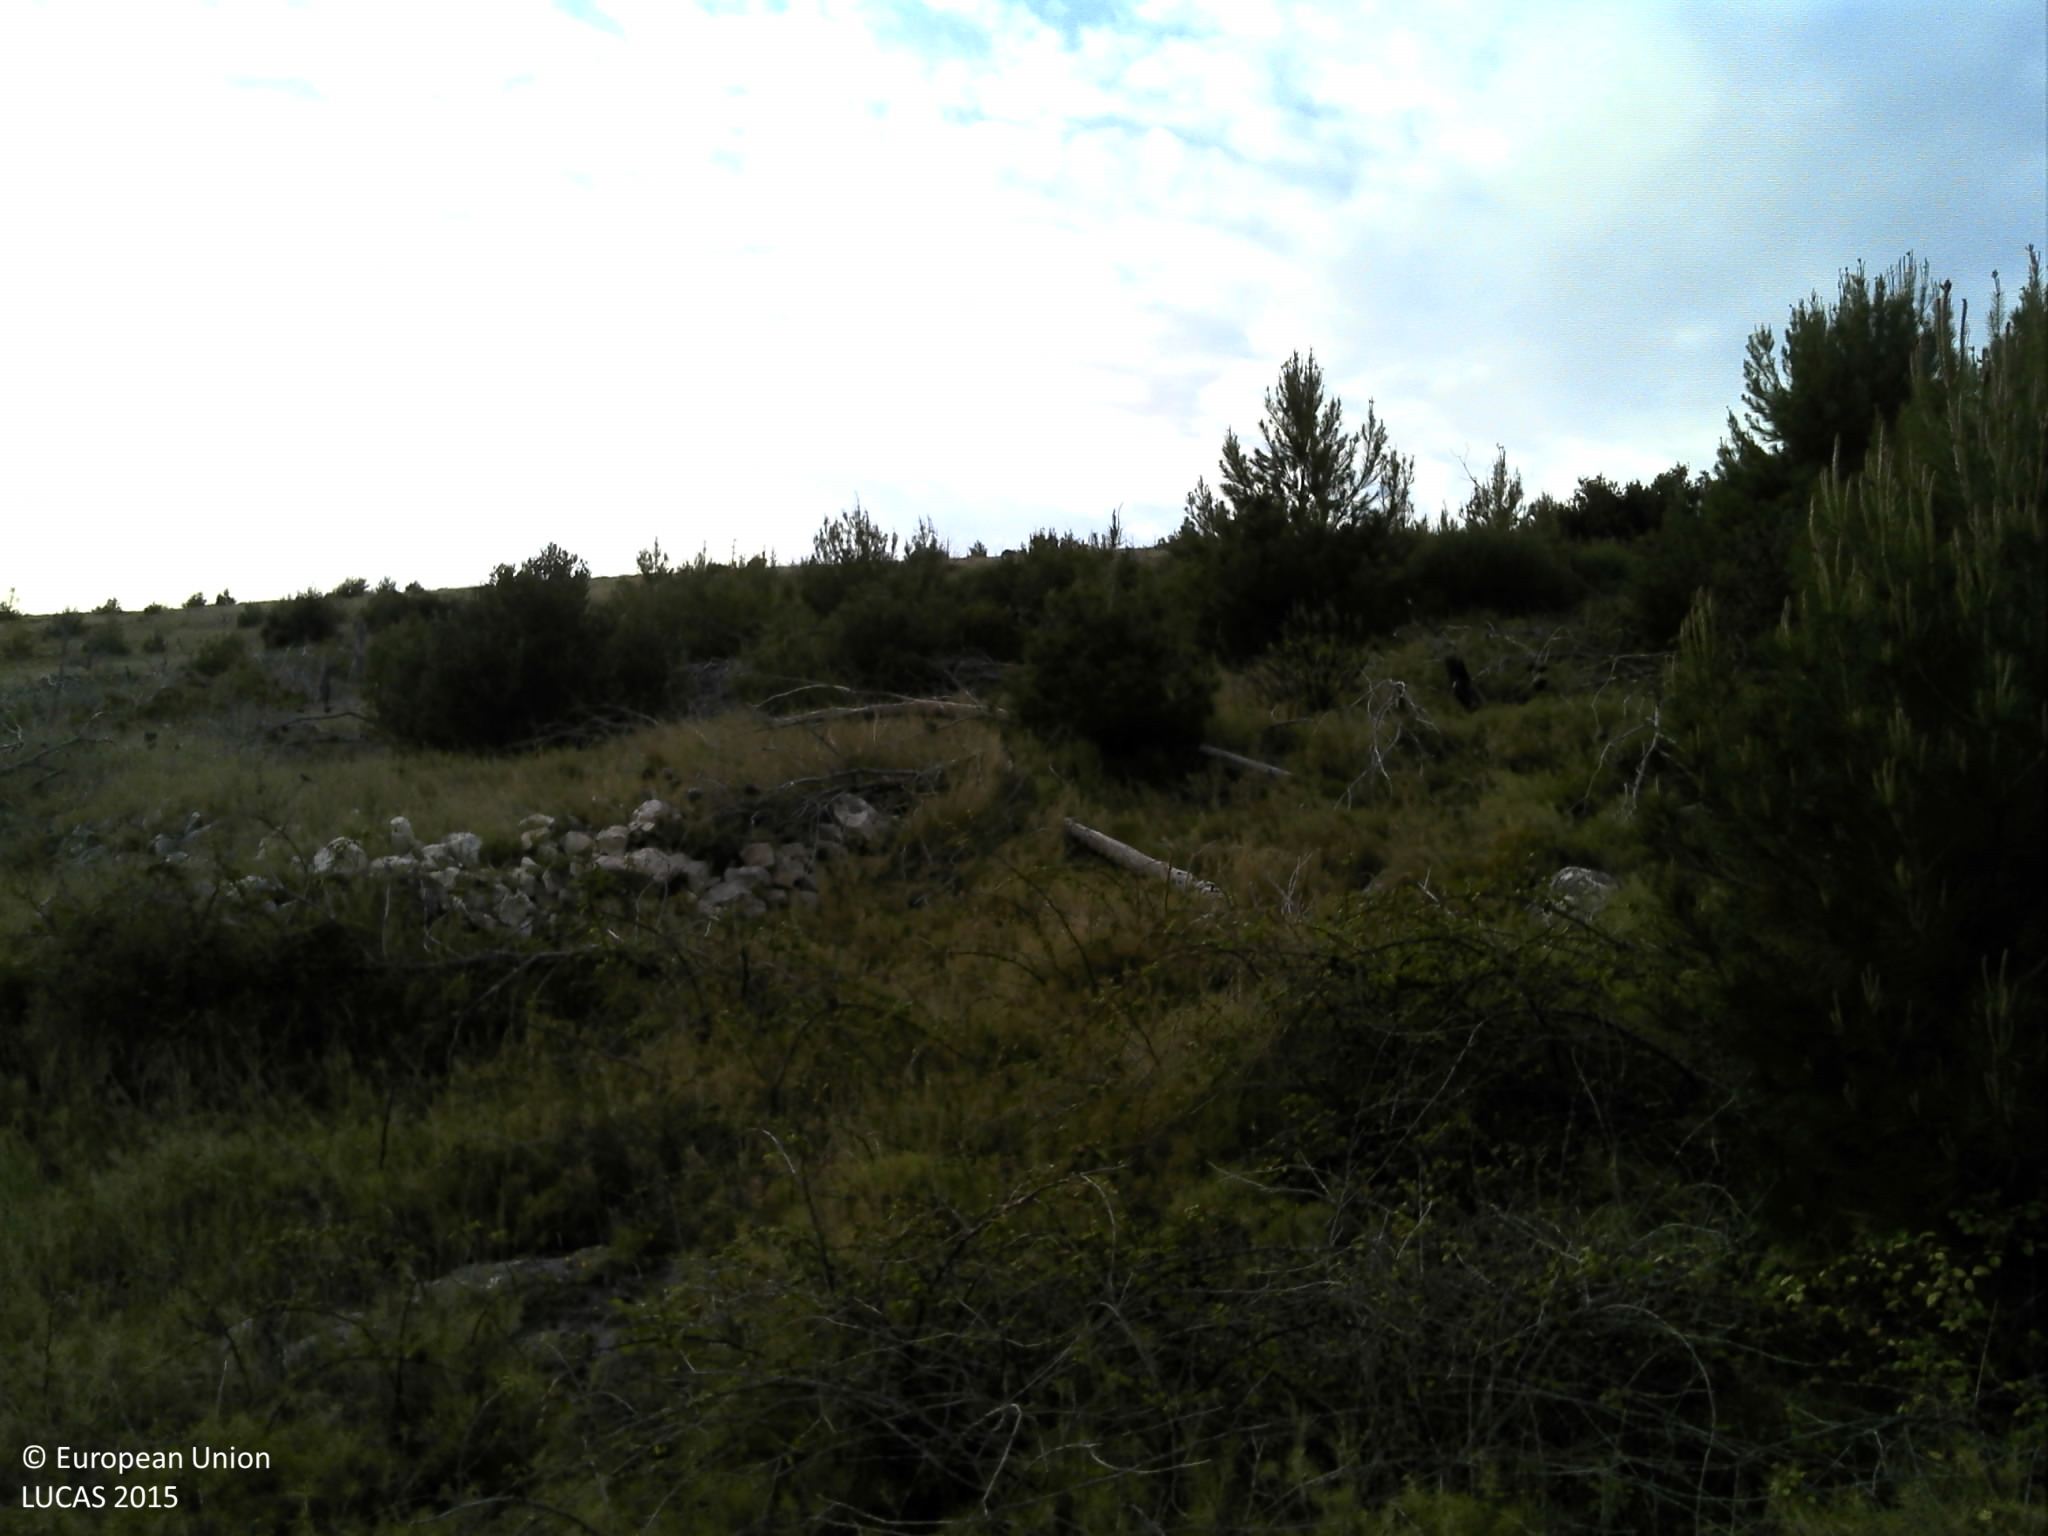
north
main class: Grassland
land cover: Grassland with sparse tree/shrub cover
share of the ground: > 75 %
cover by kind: herbaceous plants 65 %, shrubs 10 %, consolidated bare surface 10 %, unconsolidated bare surface 10 %, coniferous forest trees 5 %
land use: Abandoned areas
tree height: < 5 m
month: April
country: HR
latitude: 43.6551
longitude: 15.9549
